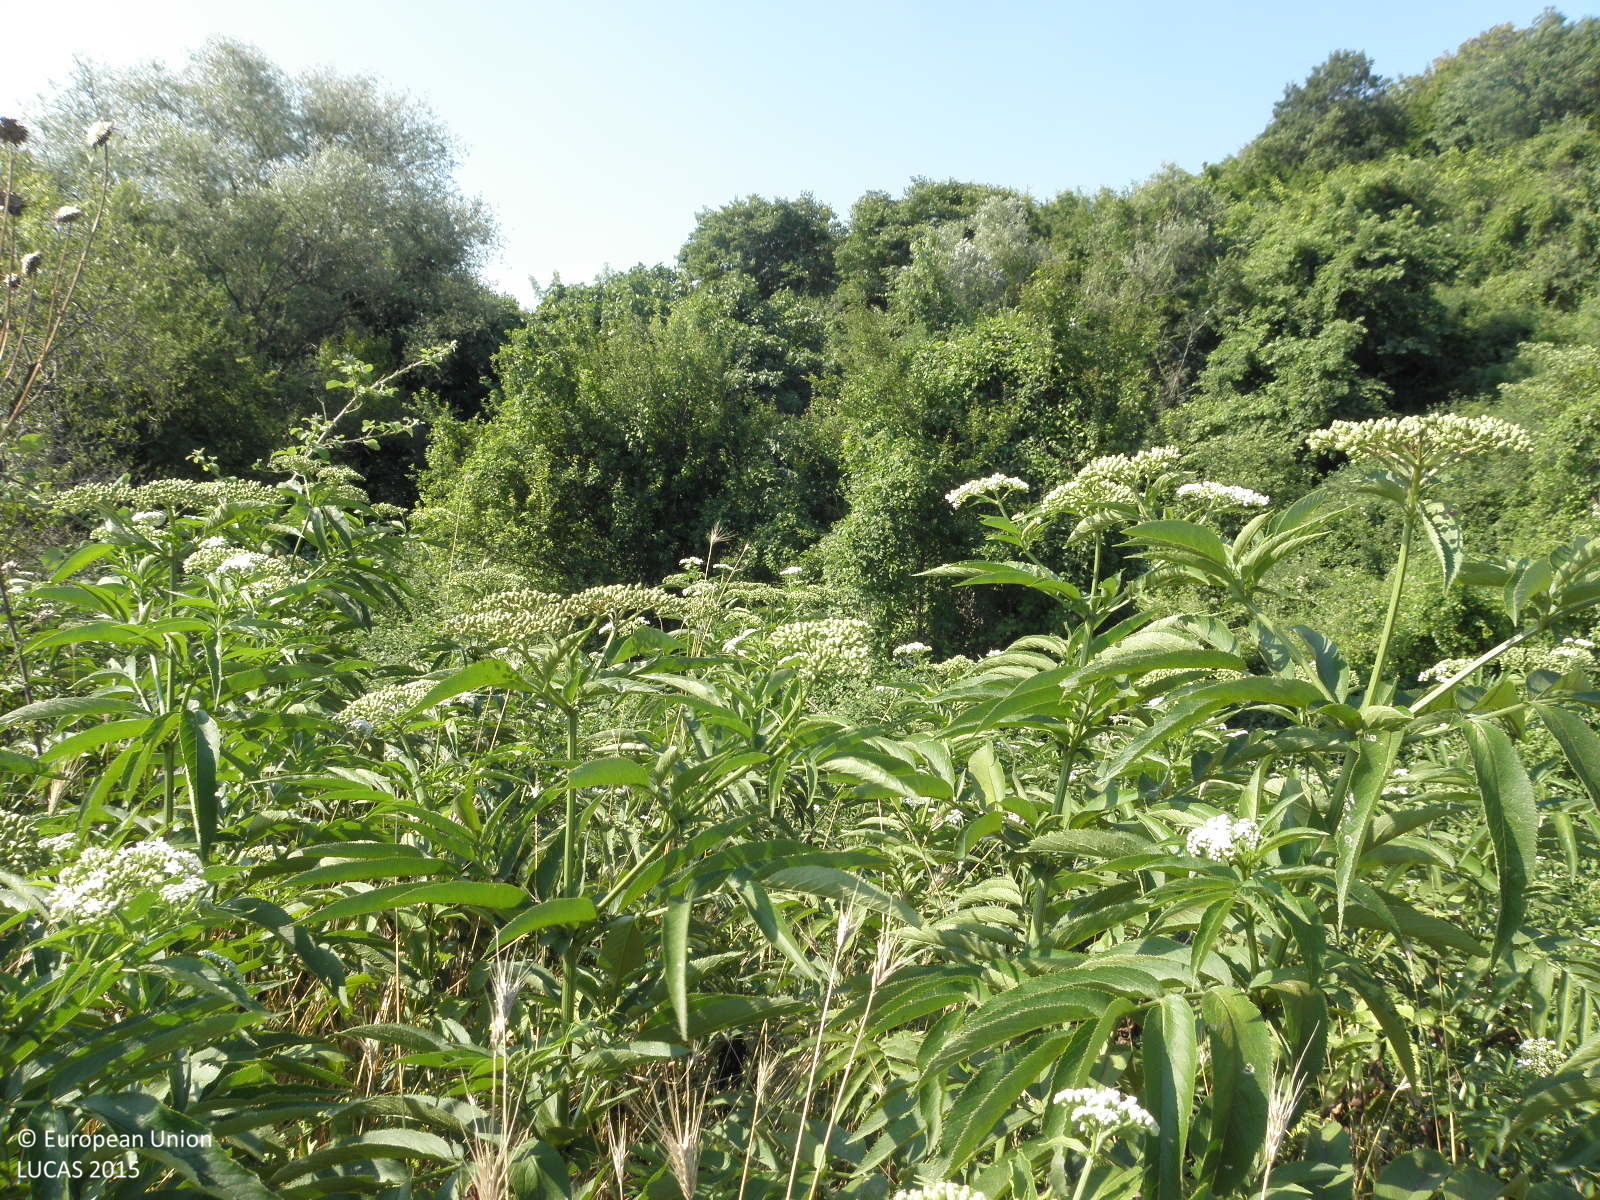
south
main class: Woodland
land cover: Broadleaved woodland
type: thermophilous deciduous forest
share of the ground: > 75 %
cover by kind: broadleaved forest trees 90 %, herbaceous plants 10 %
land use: Semi-natural and natural areas not in use
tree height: > 5 m
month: June
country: GR
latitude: 40.3731
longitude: 22.5429
